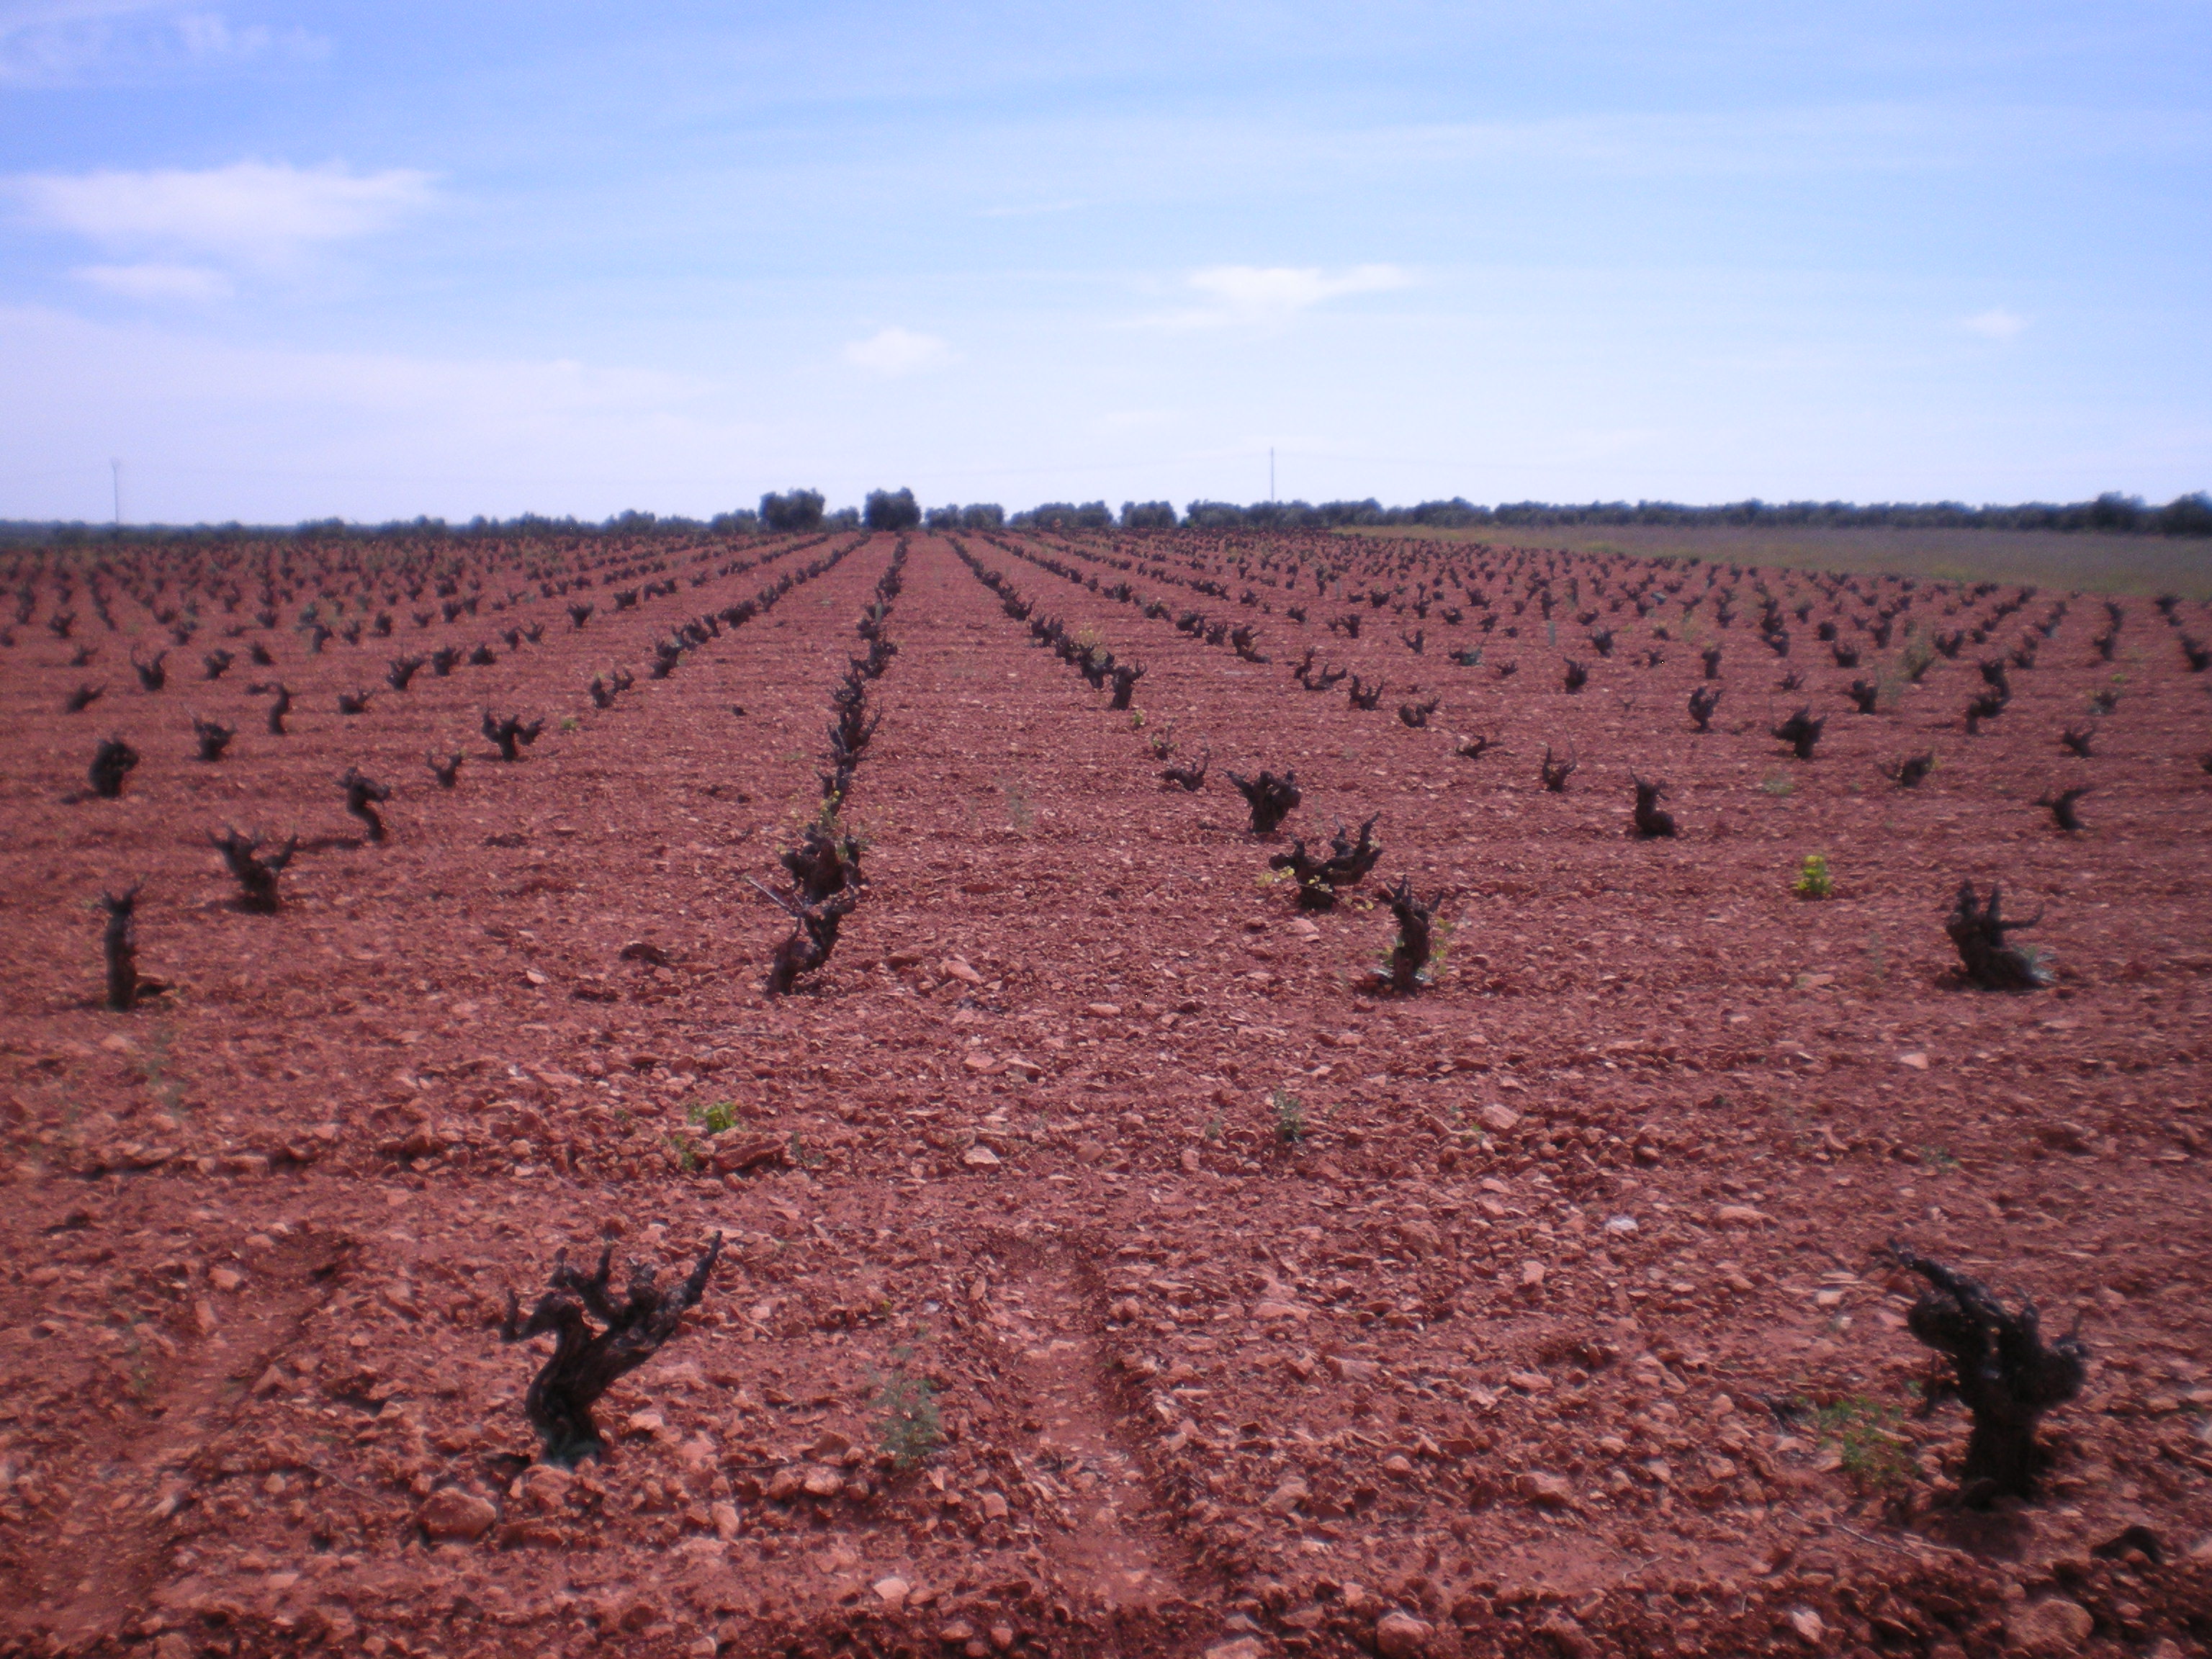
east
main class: Cropland
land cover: Vineyards
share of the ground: < 10 %
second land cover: Other bare soil
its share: > 75 %
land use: Agriculture (excluding fallow land and kitchen gardens)
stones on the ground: 10 - 25 %
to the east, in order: Vineyards; Other bare soil
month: April
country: ES
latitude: 38.8157
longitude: -3.2431
